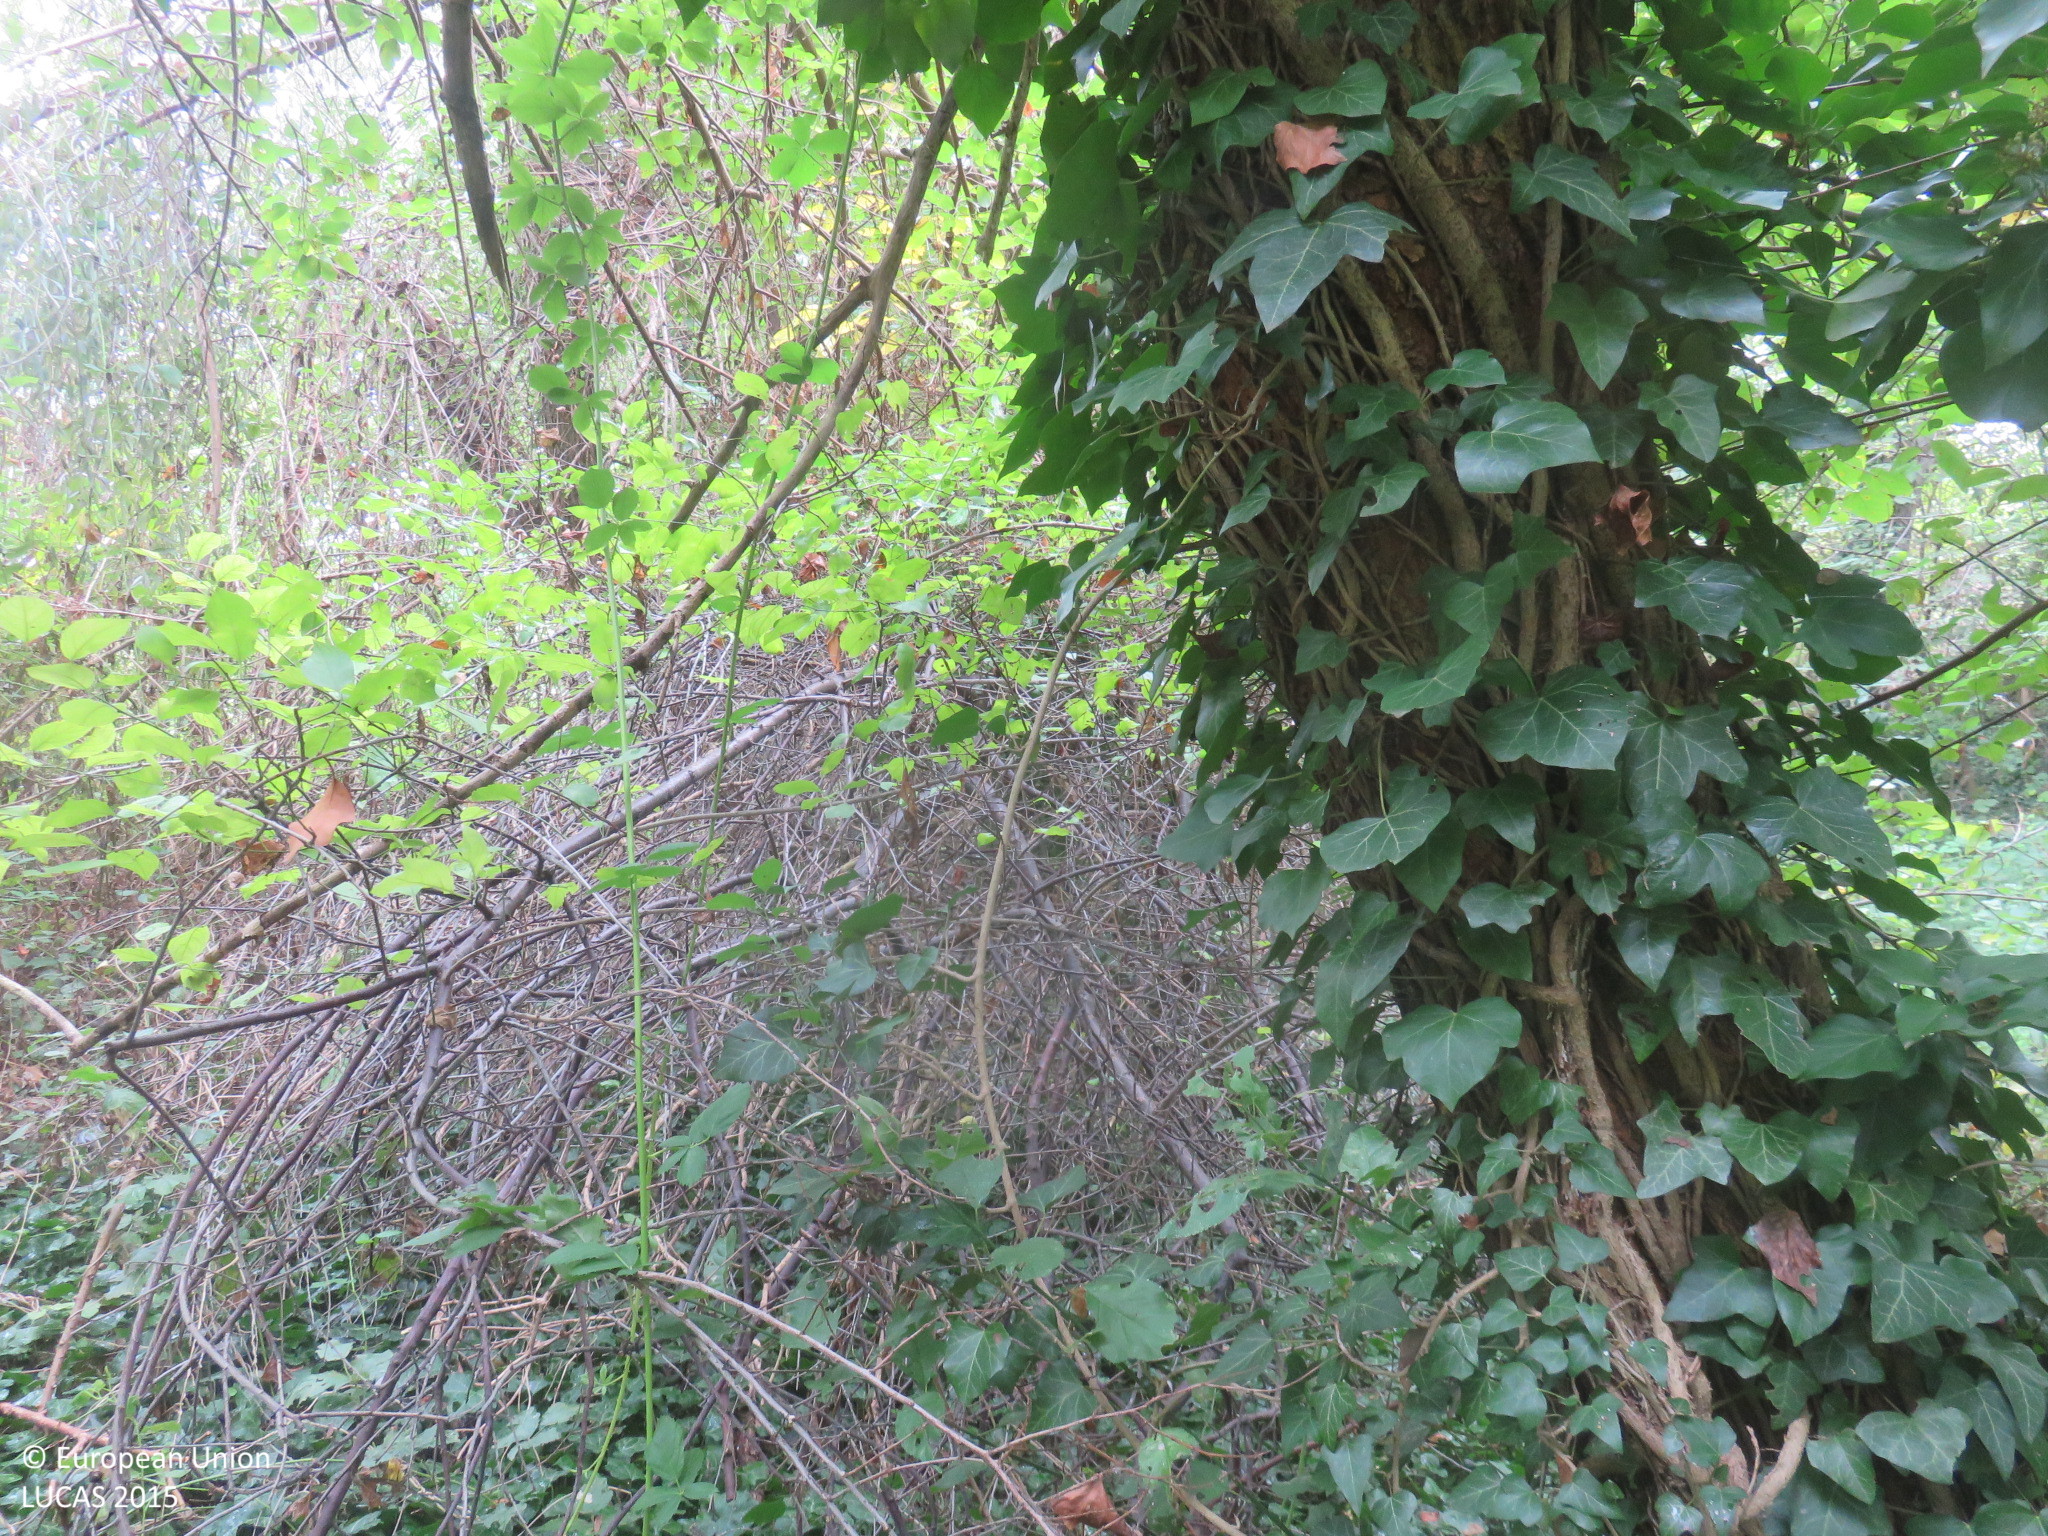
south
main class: Woodland
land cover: Broadleaved woodland
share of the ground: > 75 %
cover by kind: broadleaved forest trees 80 %, shrubs 10 %, herbaceous plants 10 %
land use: Residential
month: September
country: BG
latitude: 43.0999
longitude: 24.7947
